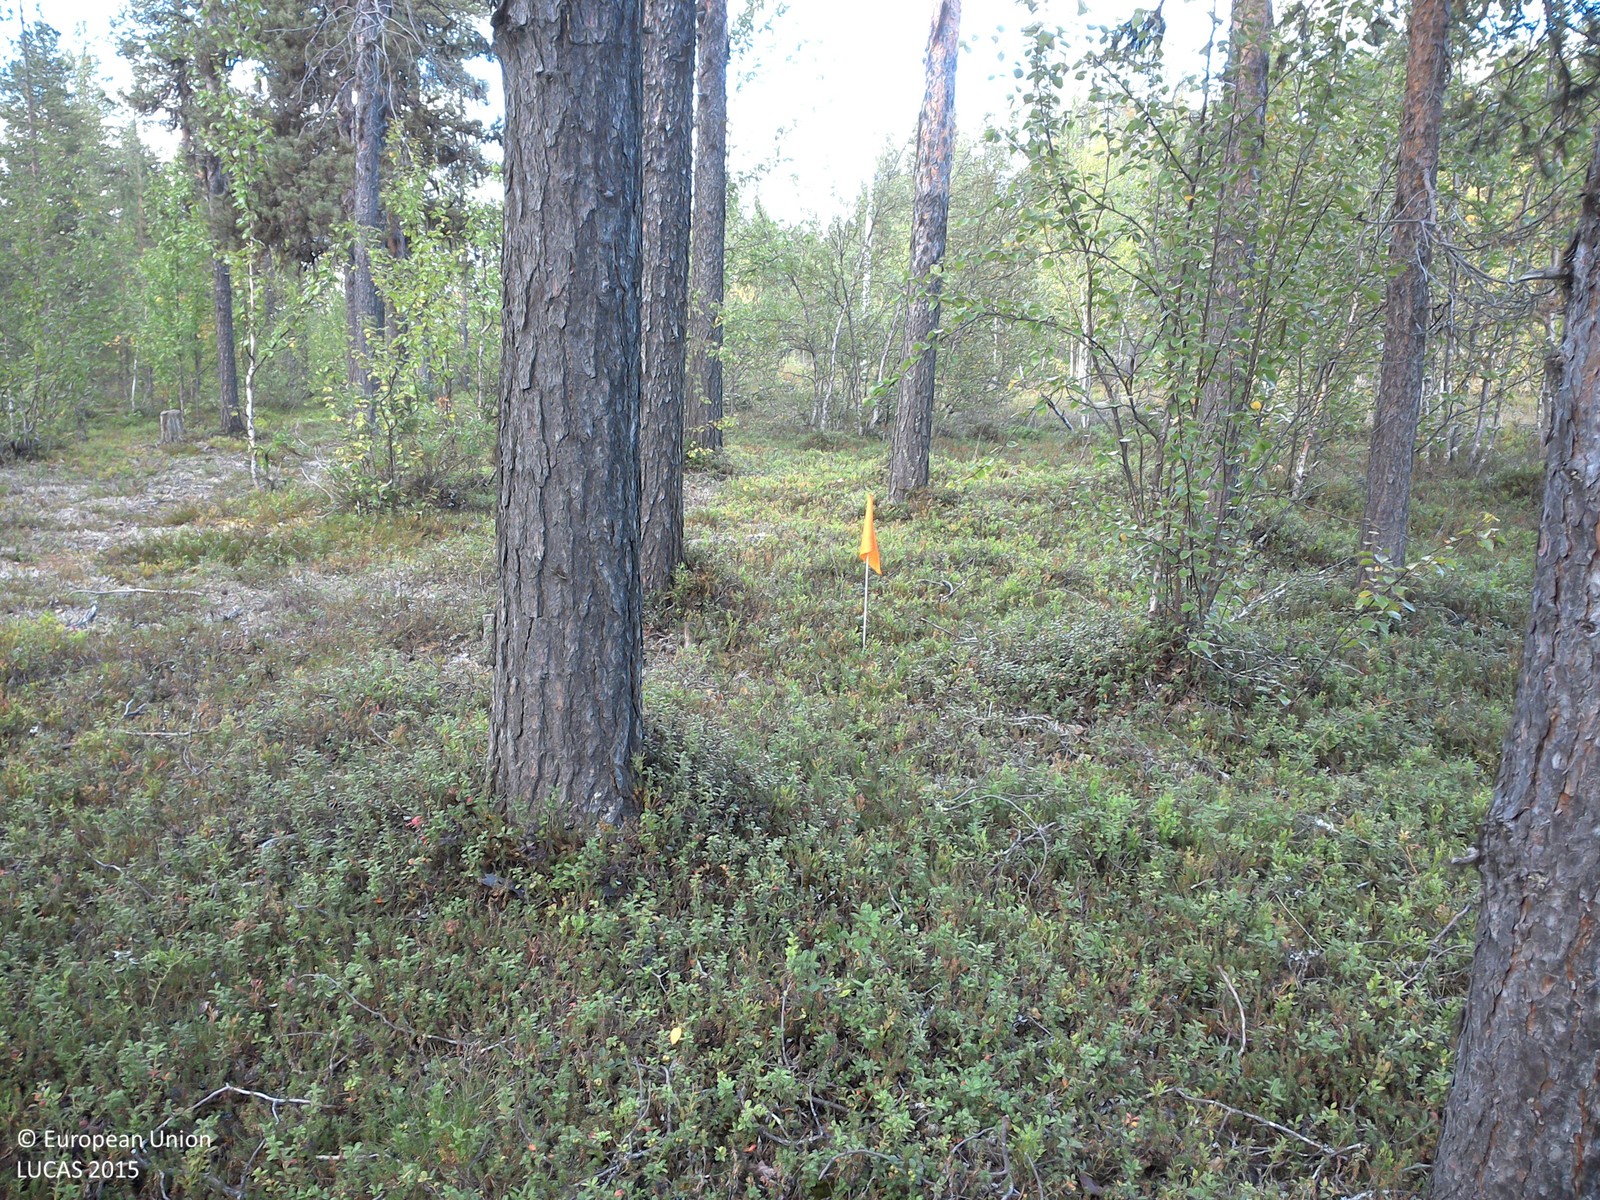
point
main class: Woodland
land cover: Pine dominated mixed woodland
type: boreal forest
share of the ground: 25 - 50 %
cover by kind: shrubs 60 %, coniferous forest trees 25 %, broadleaved forest trees 10 %, lichens and mosses 5 %
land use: Forestry
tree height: > 5 m
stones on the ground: < 10 %
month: August
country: SE
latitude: 68.1600
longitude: 23.0814
